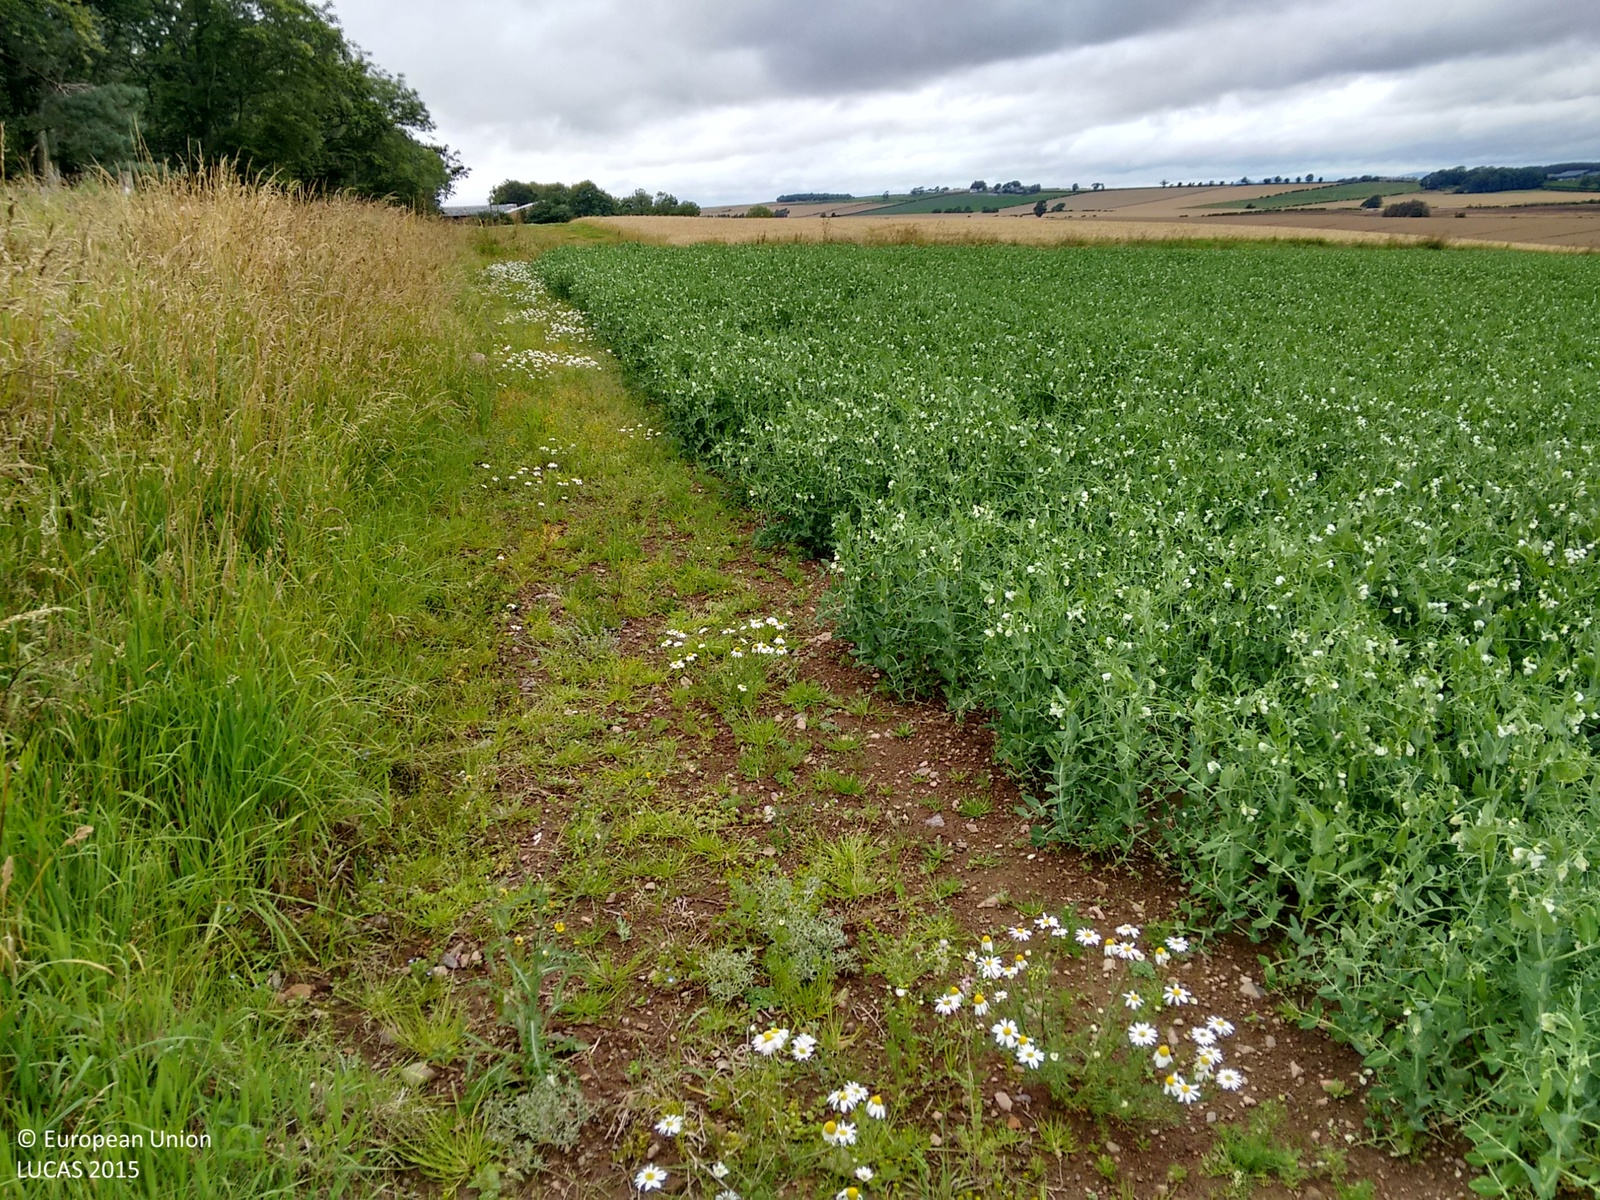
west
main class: Cropland
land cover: Dry pulses
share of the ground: > 75 %
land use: Agriculture (excluding fallow land and kitchen gardens)
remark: Tilled/Sowed
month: August
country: GB
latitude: 55.5940
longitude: -2.2920
